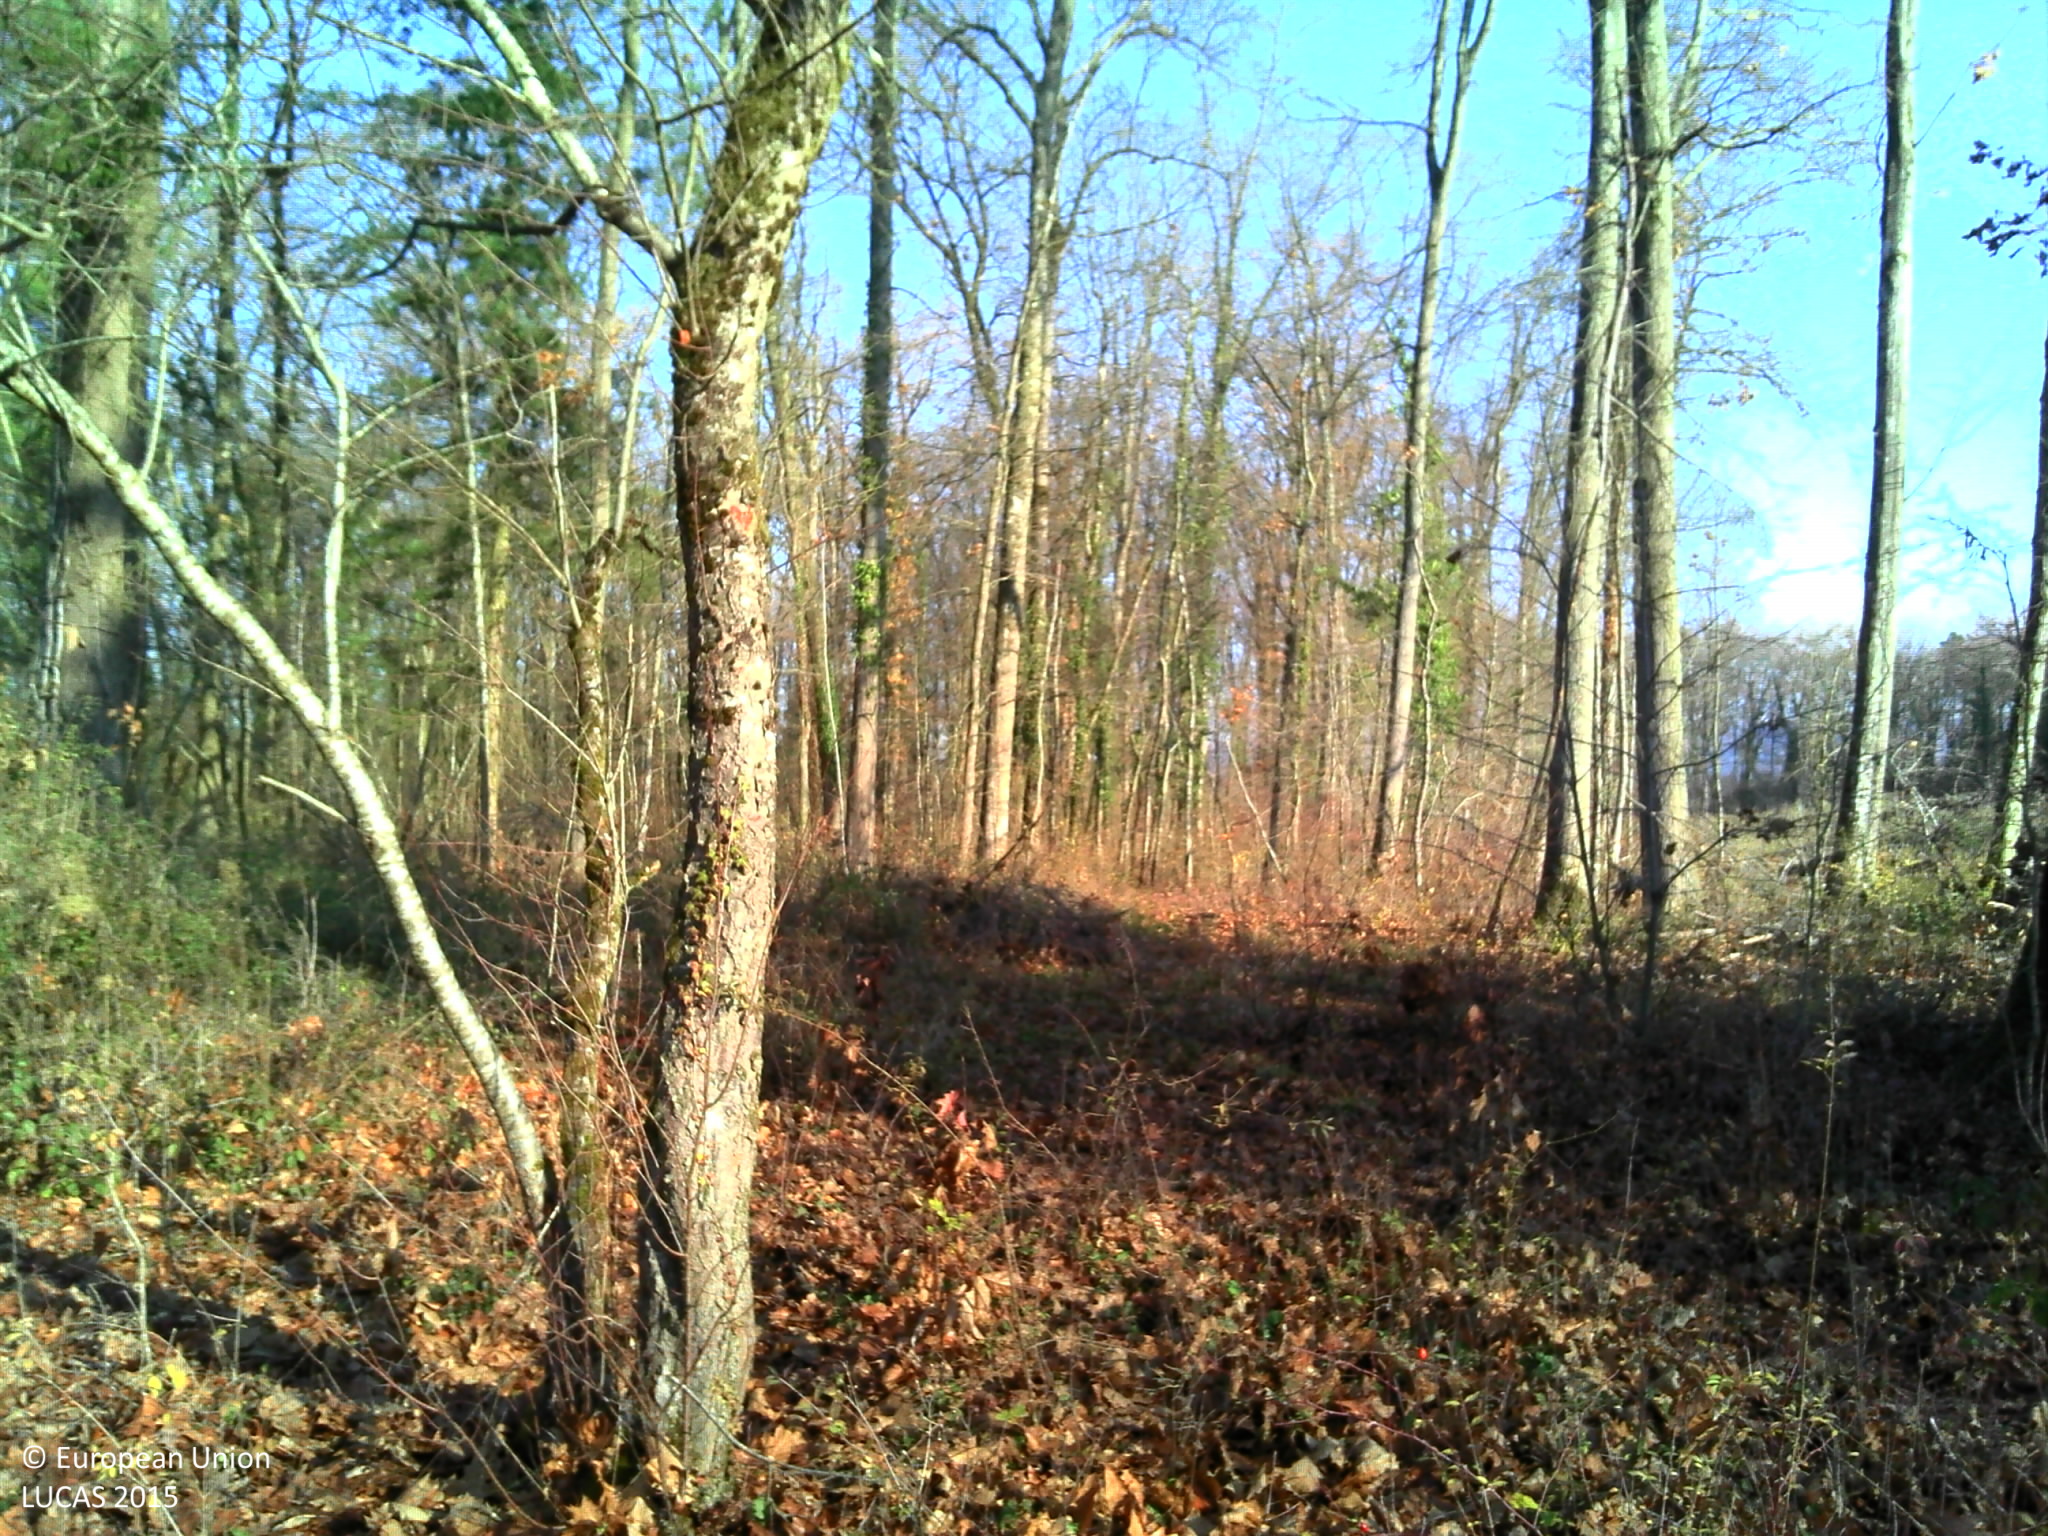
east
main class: Woodland
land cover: Pine dominated mixed woodland
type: mesophytic deciduous forest
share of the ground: > 75 %
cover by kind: coniferous forest trees 45 %, broadleaved forest trees 45 %, herbaceous plants 10 %
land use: Forestry
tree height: > 5 m
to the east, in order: Pine dominated mixed woodland; Tracks; Spontaneously vegetated surfaces; Pine dominated mixed woodland; Tracks; Pine dominated mixed woodland
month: December
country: FR
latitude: 45.8691
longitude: 5.3018
